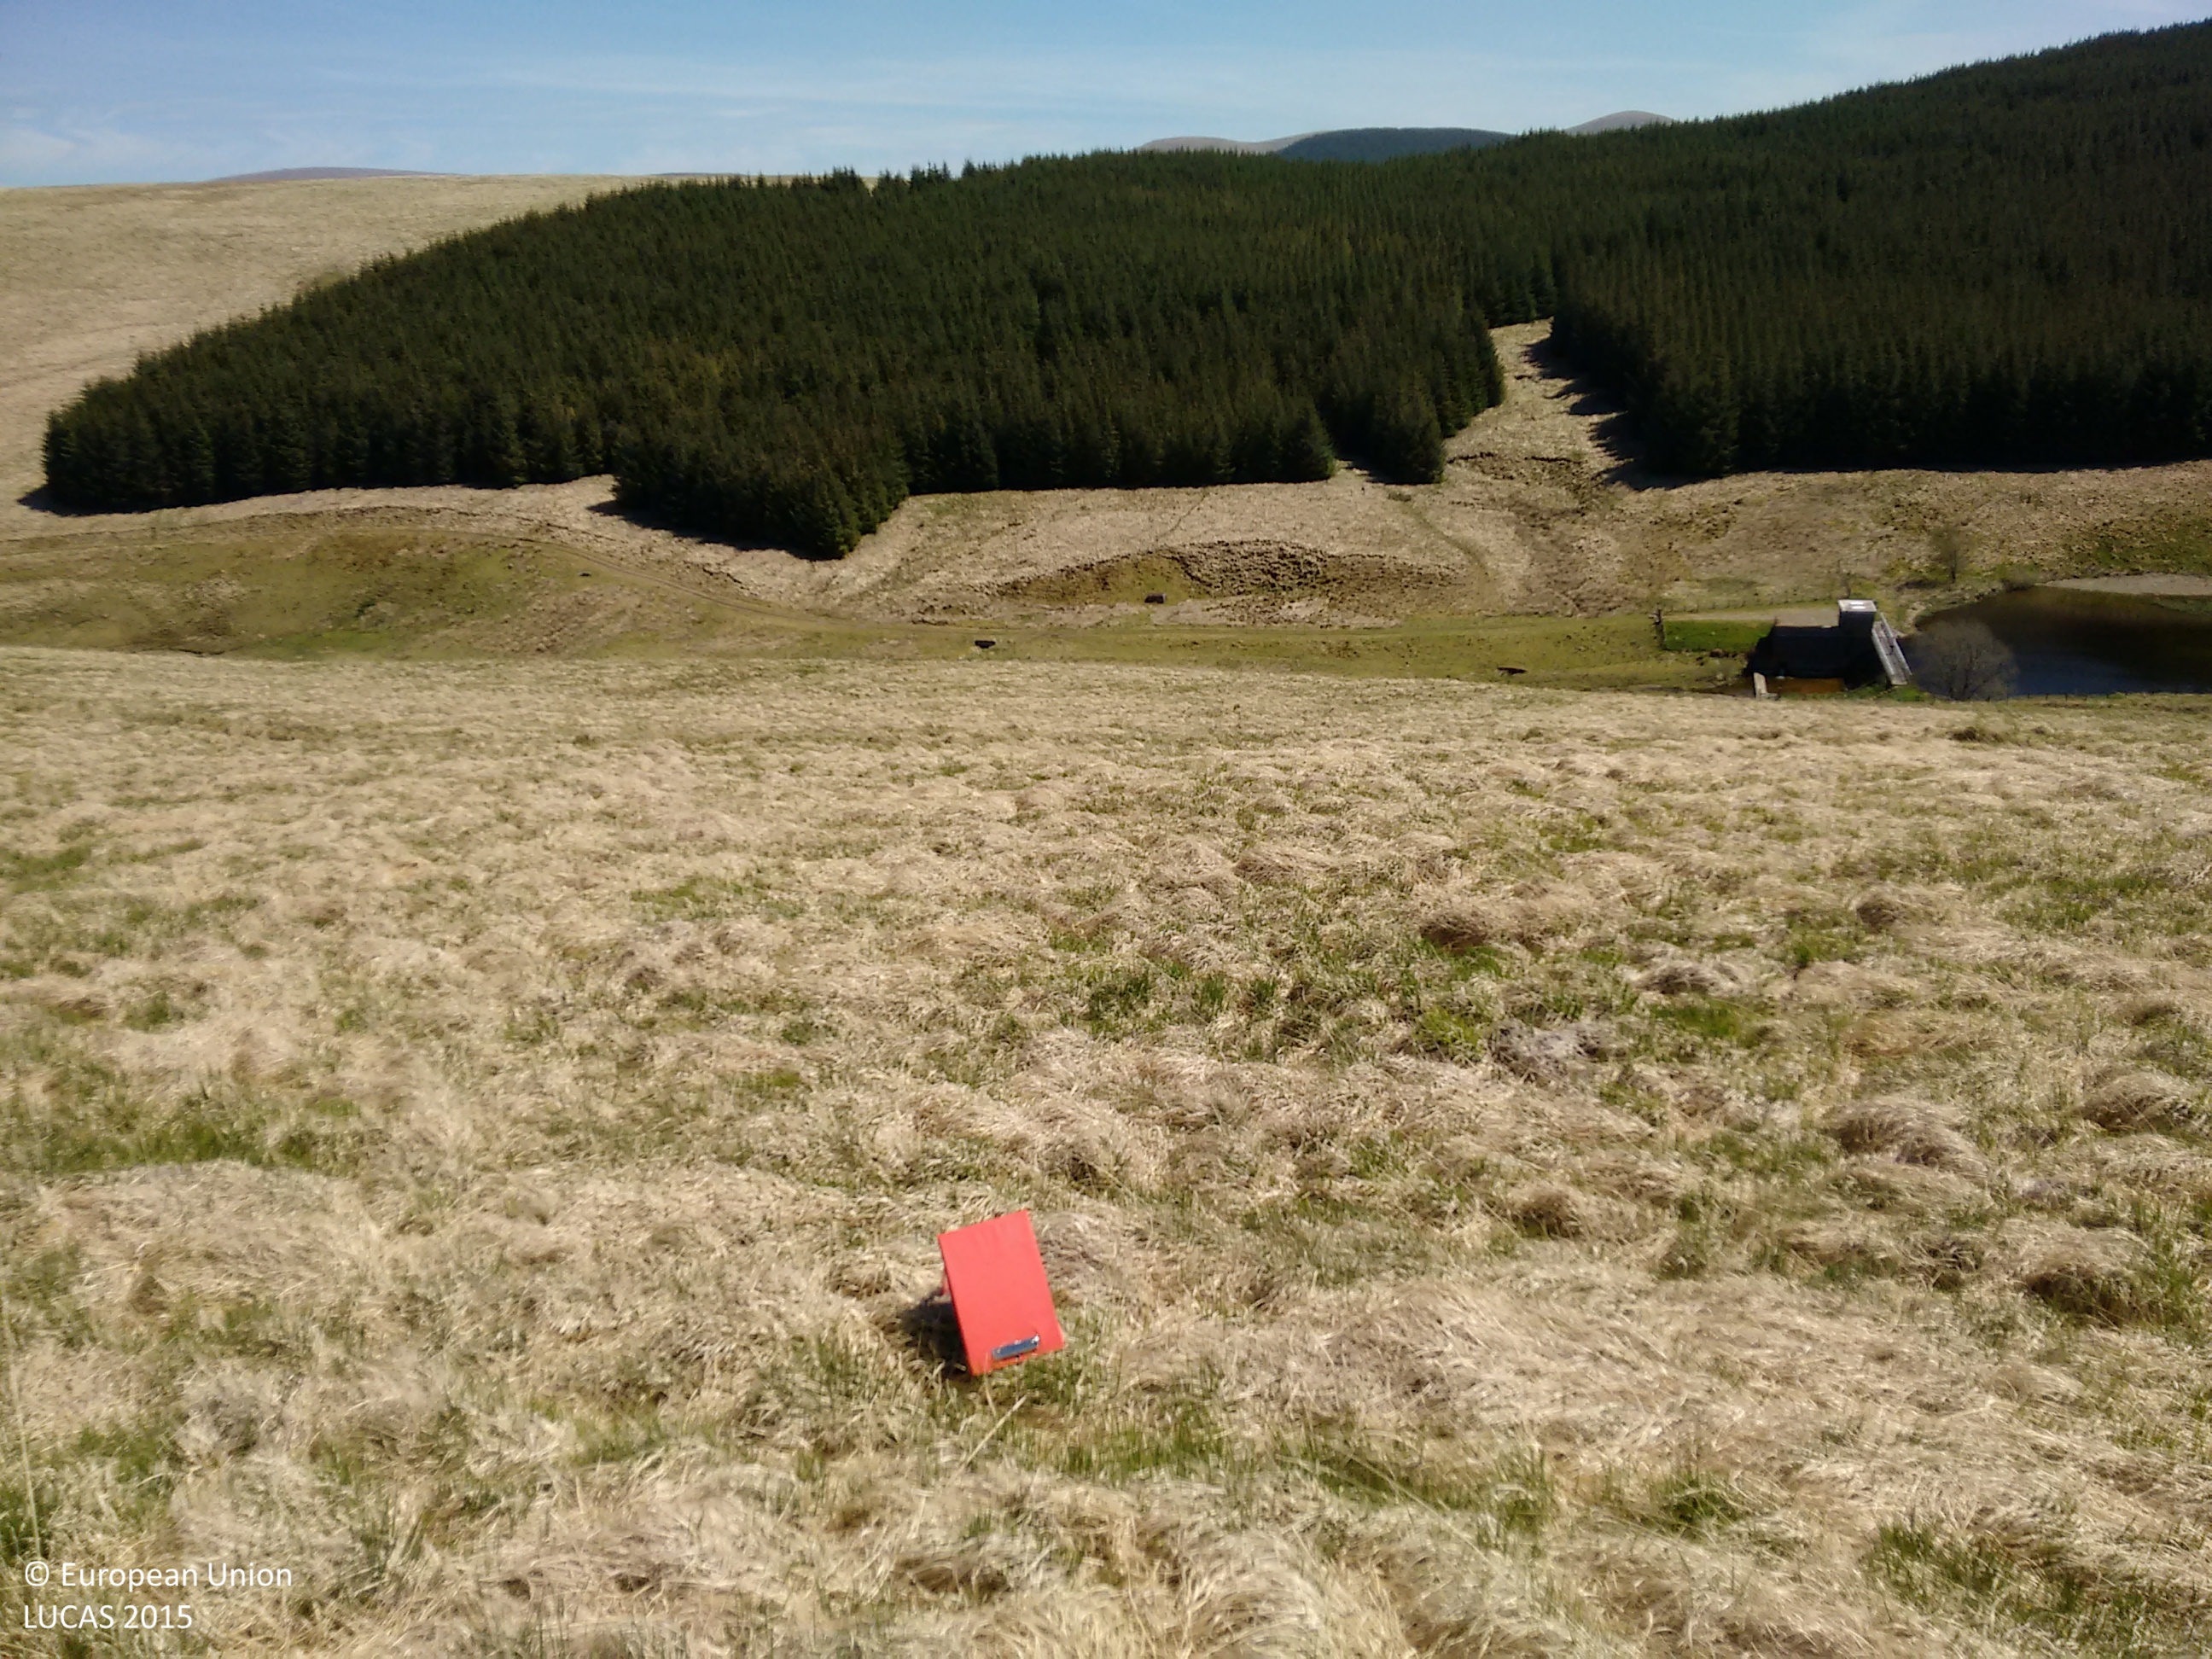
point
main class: Grassland
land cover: Grassland without tree/shrub cover
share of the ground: > 75 %
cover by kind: herbaceous plants 100 %
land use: Semi-natural and natural areas not in use
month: June
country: GB
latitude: 55.4723
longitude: -3.4779
